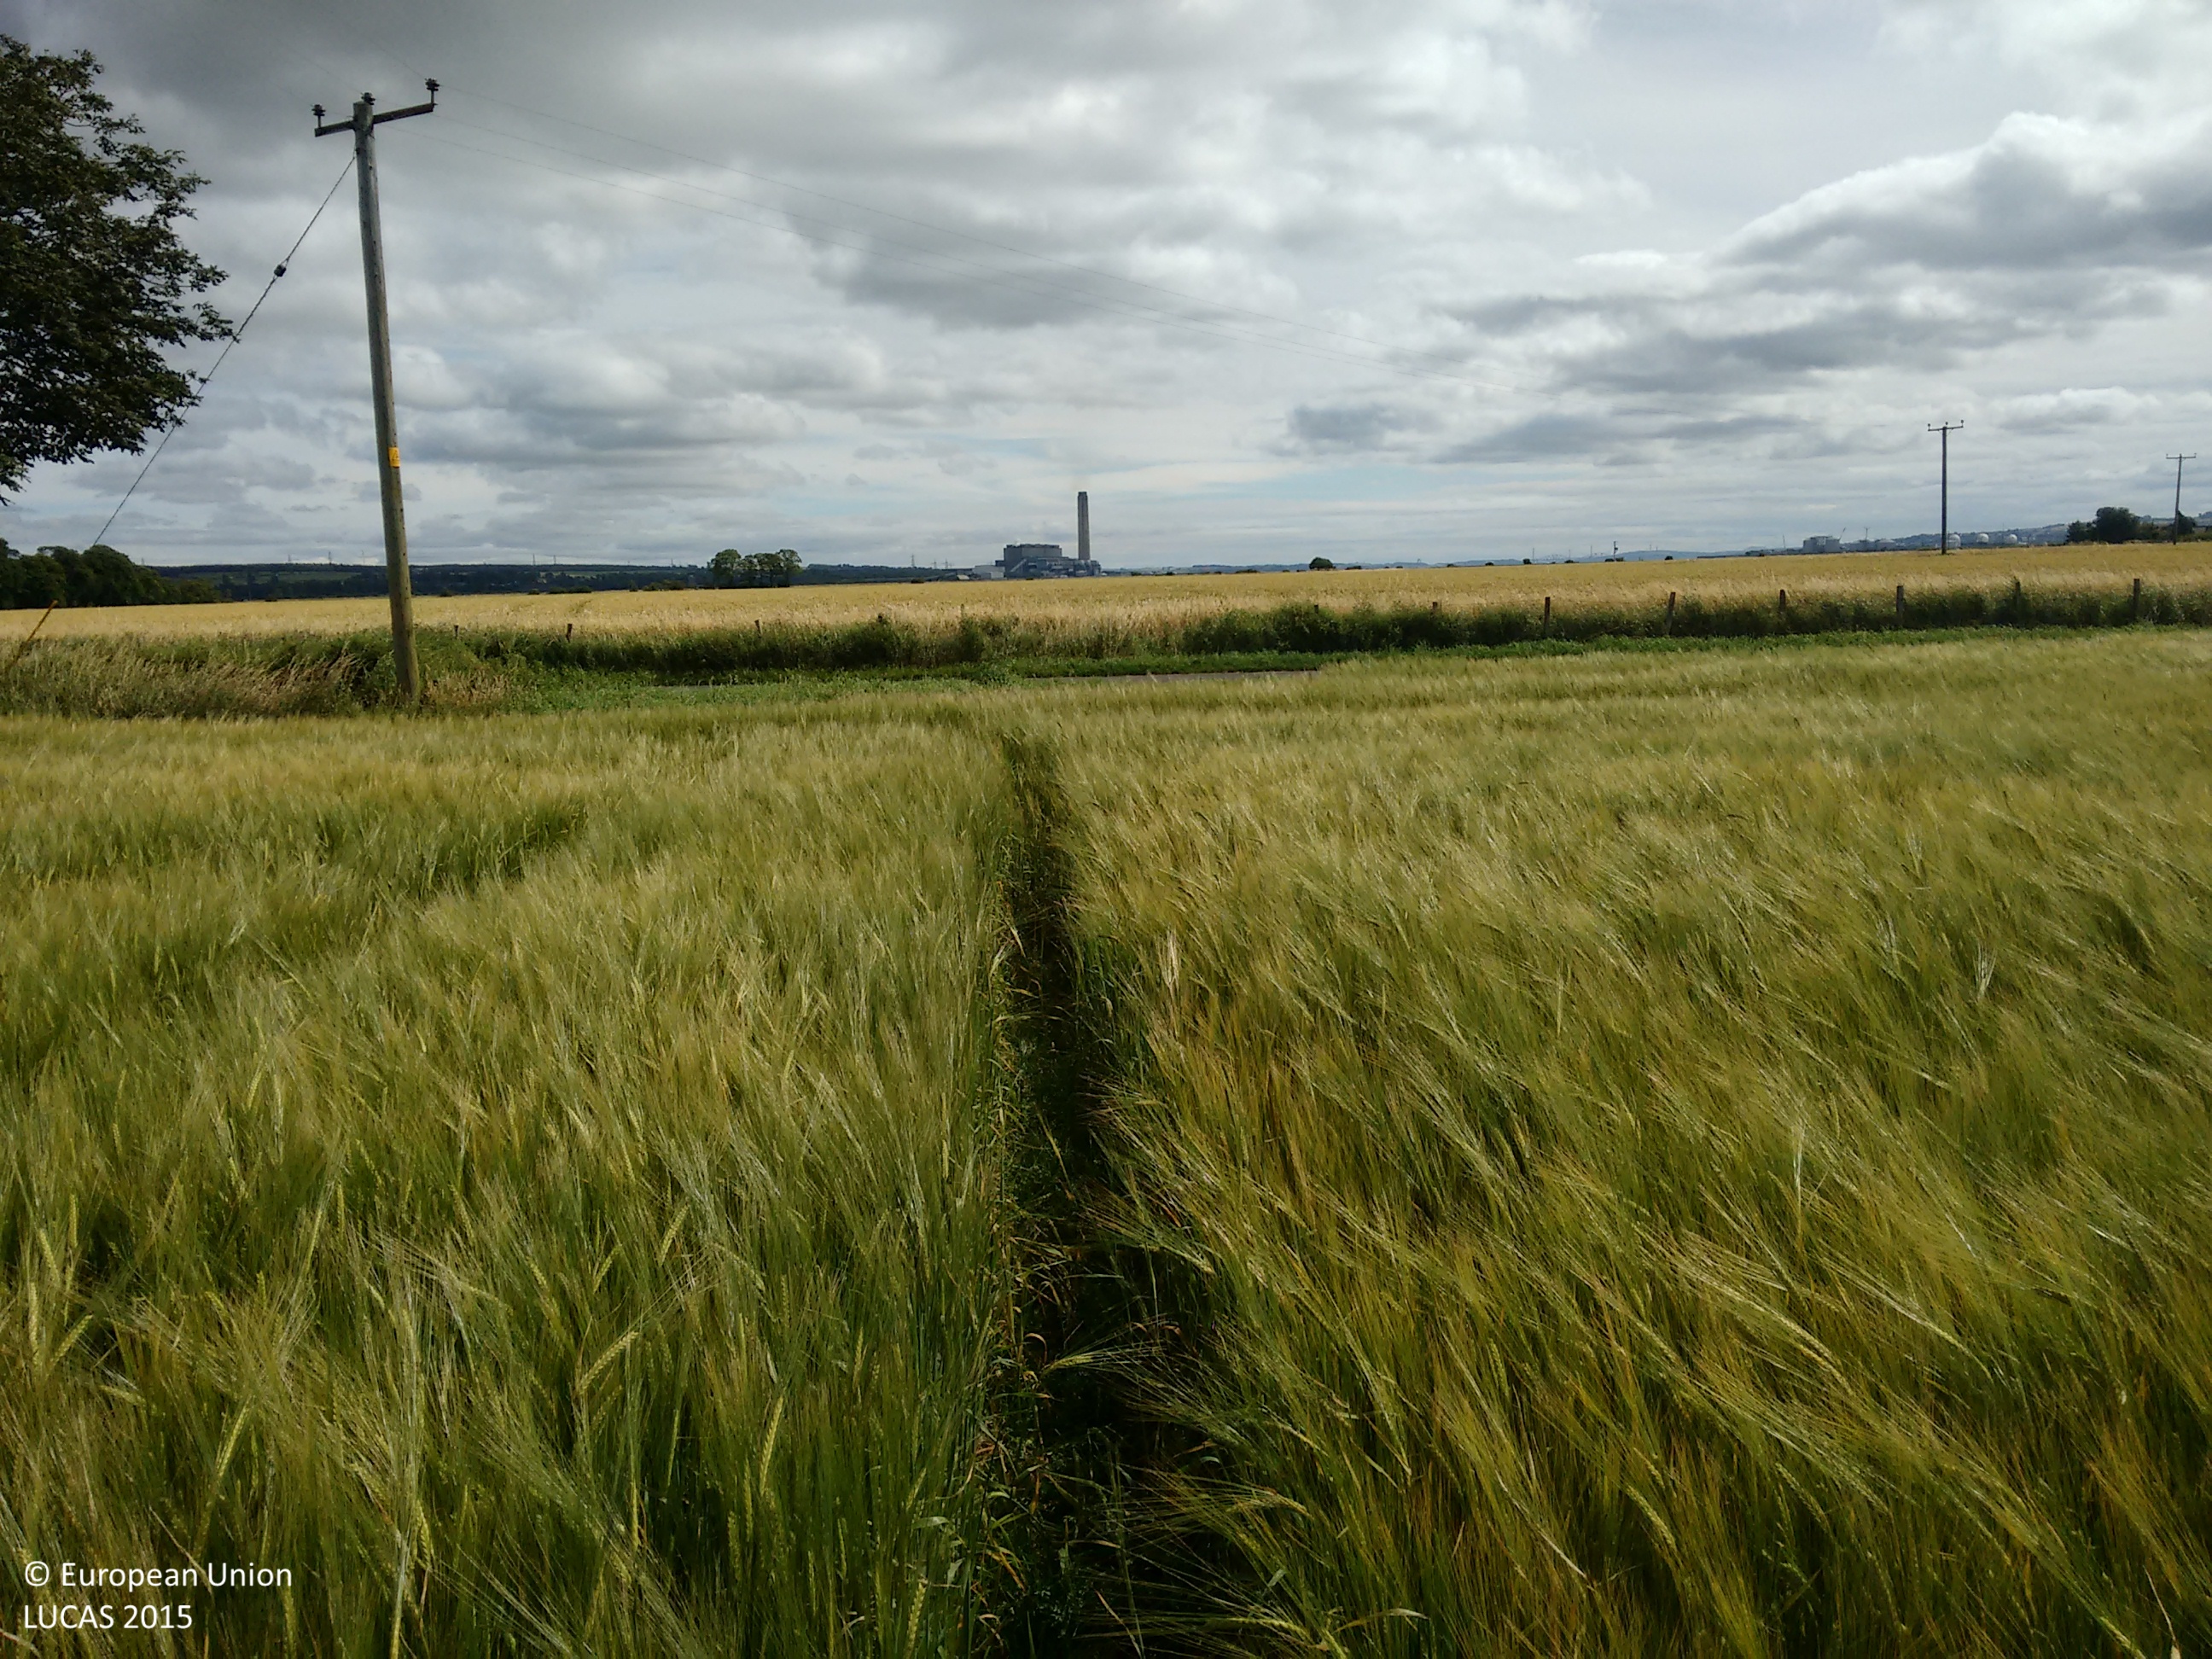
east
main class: Cropland
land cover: Barley
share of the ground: > 75 %
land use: Agriculture (excluding fallow land and kitchen gardens)
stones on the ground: < 10 %
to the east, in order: Barley; Grass margins; Paved roads, cycling and walking lanes; Grass margins; Fences; Grass margins; Common wheat; Electric lines; Common wheat
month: August
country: GB
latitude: 56.0463
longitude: -3.7437
